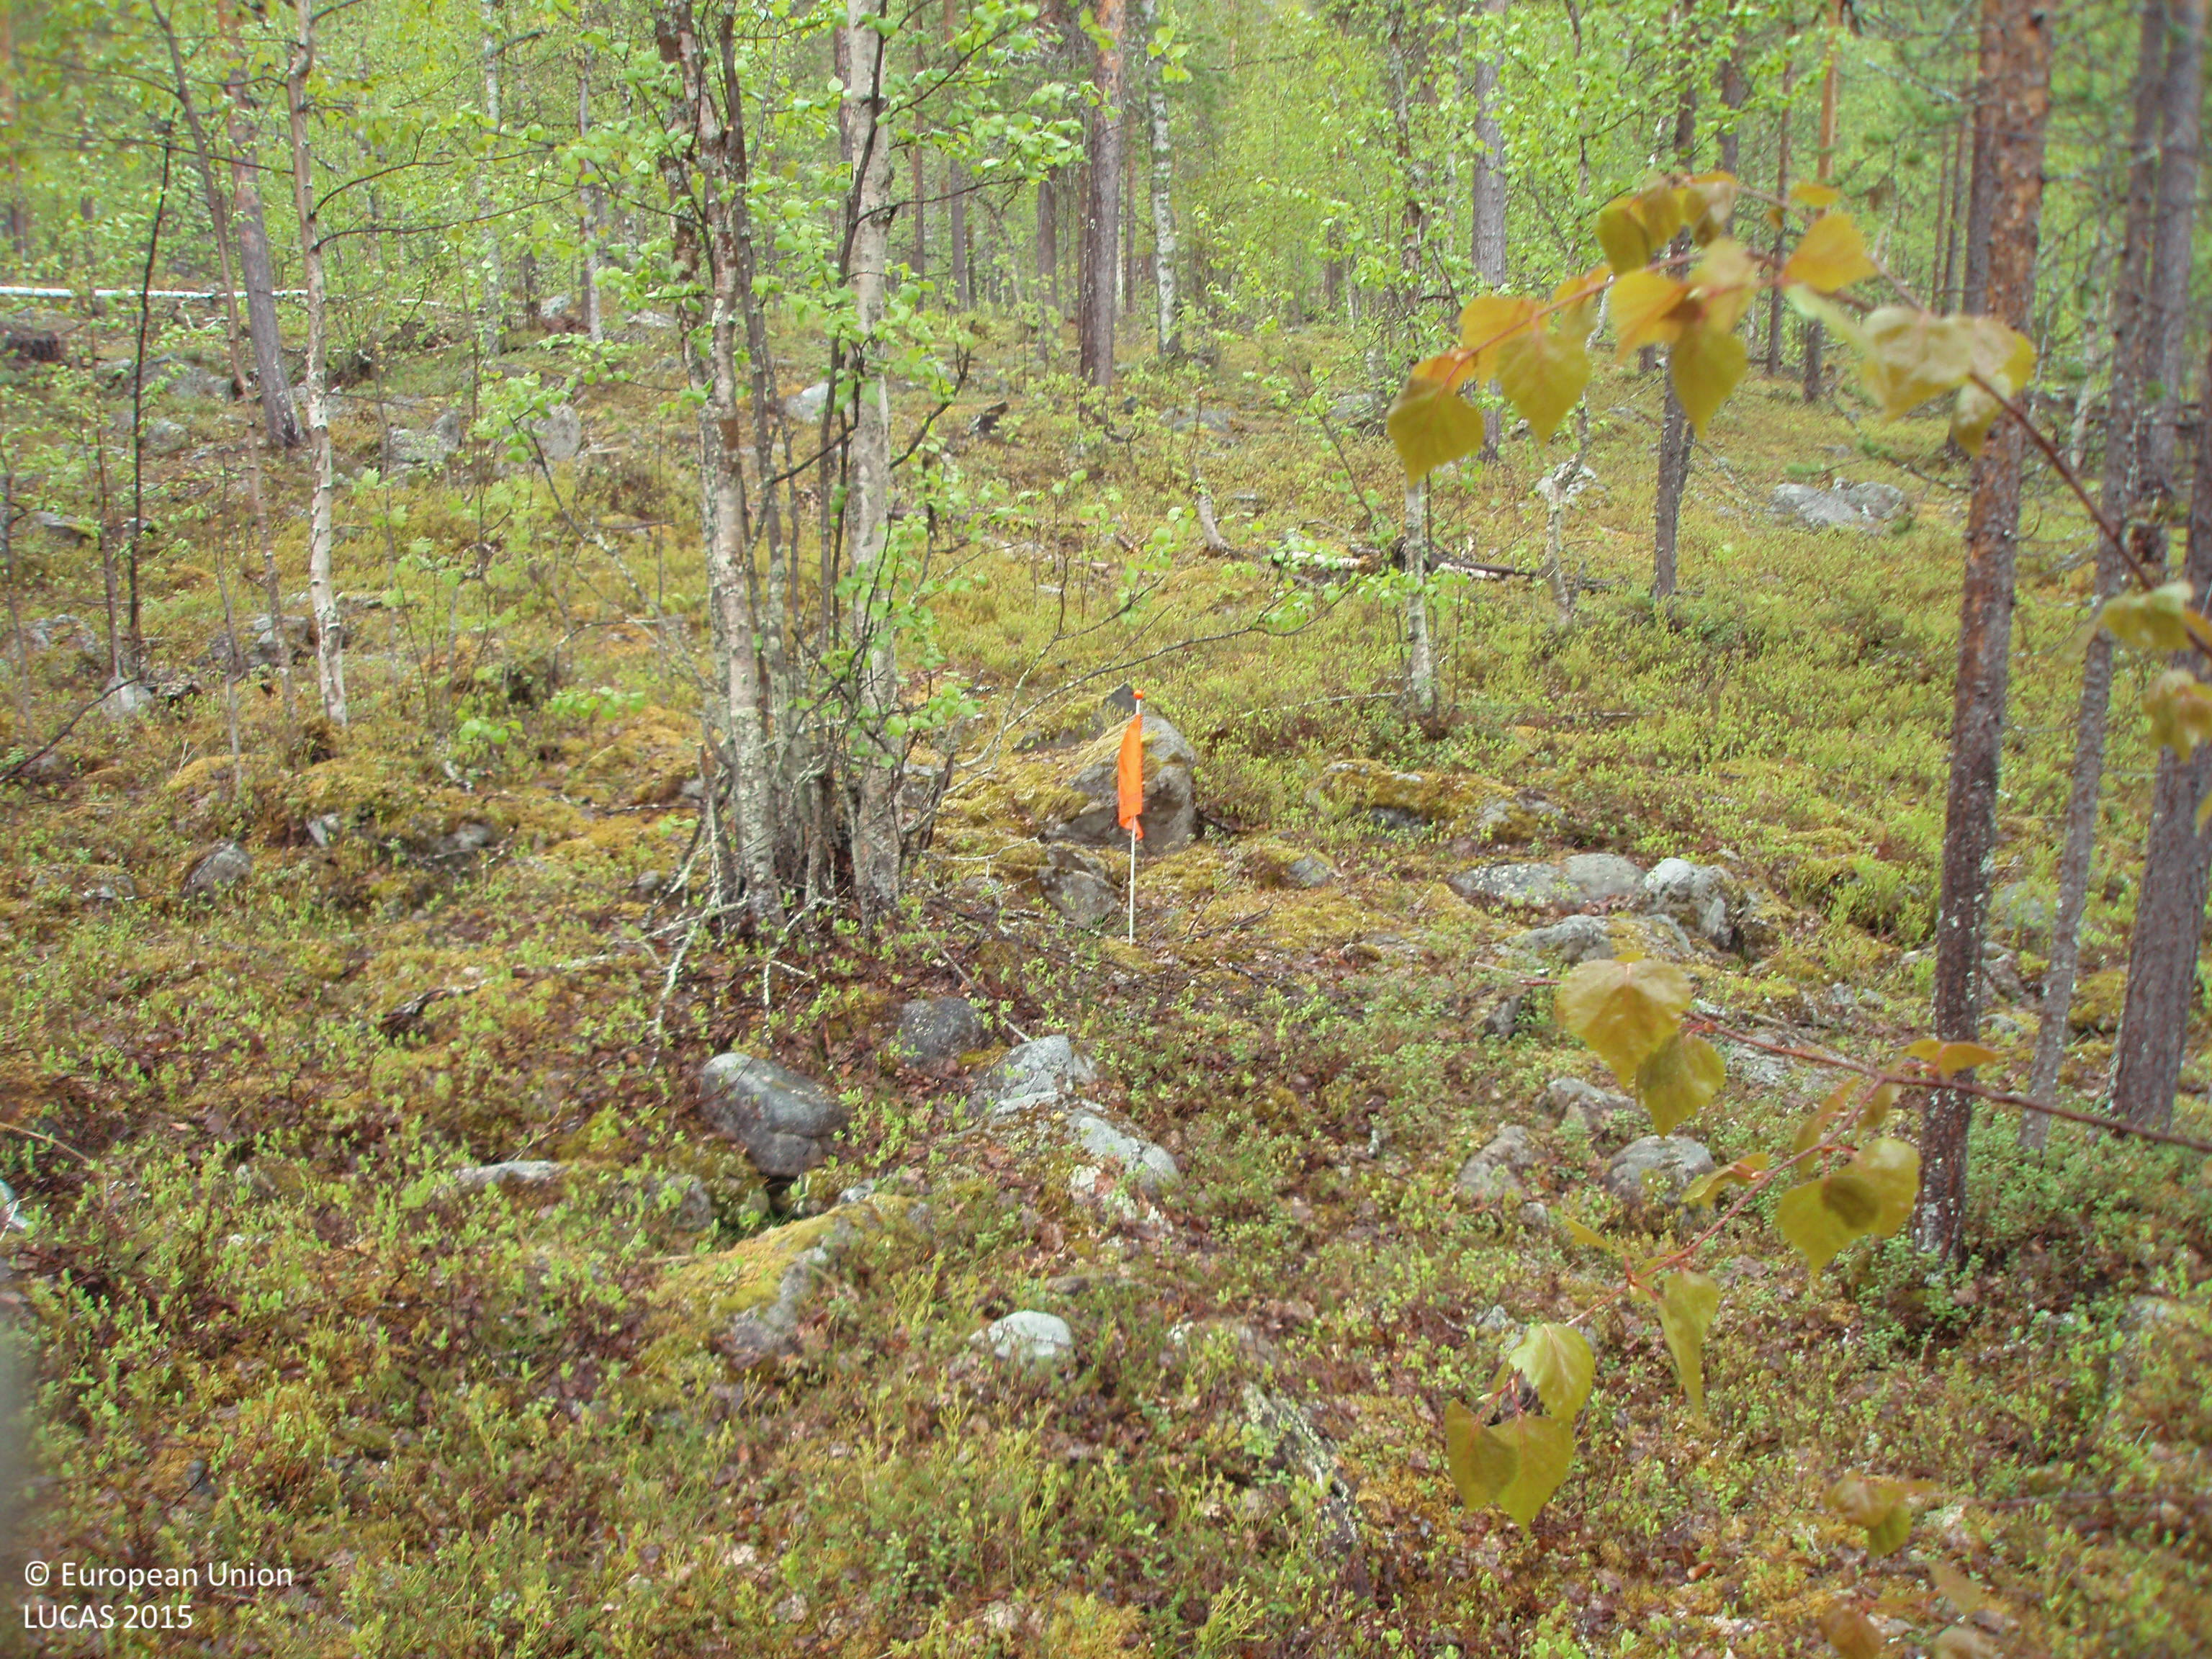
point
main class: Woodland
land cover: Pine dominated mixed woodland
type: boreal forest
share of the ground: 50 - 75 %
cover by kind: coniferous forest trees 35 %, shrubs 35 %, broadleaved forest trees 30 %
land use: Forestry
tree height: > 5 m
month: June
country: FI
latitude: 67.6081
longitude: 26.3682
